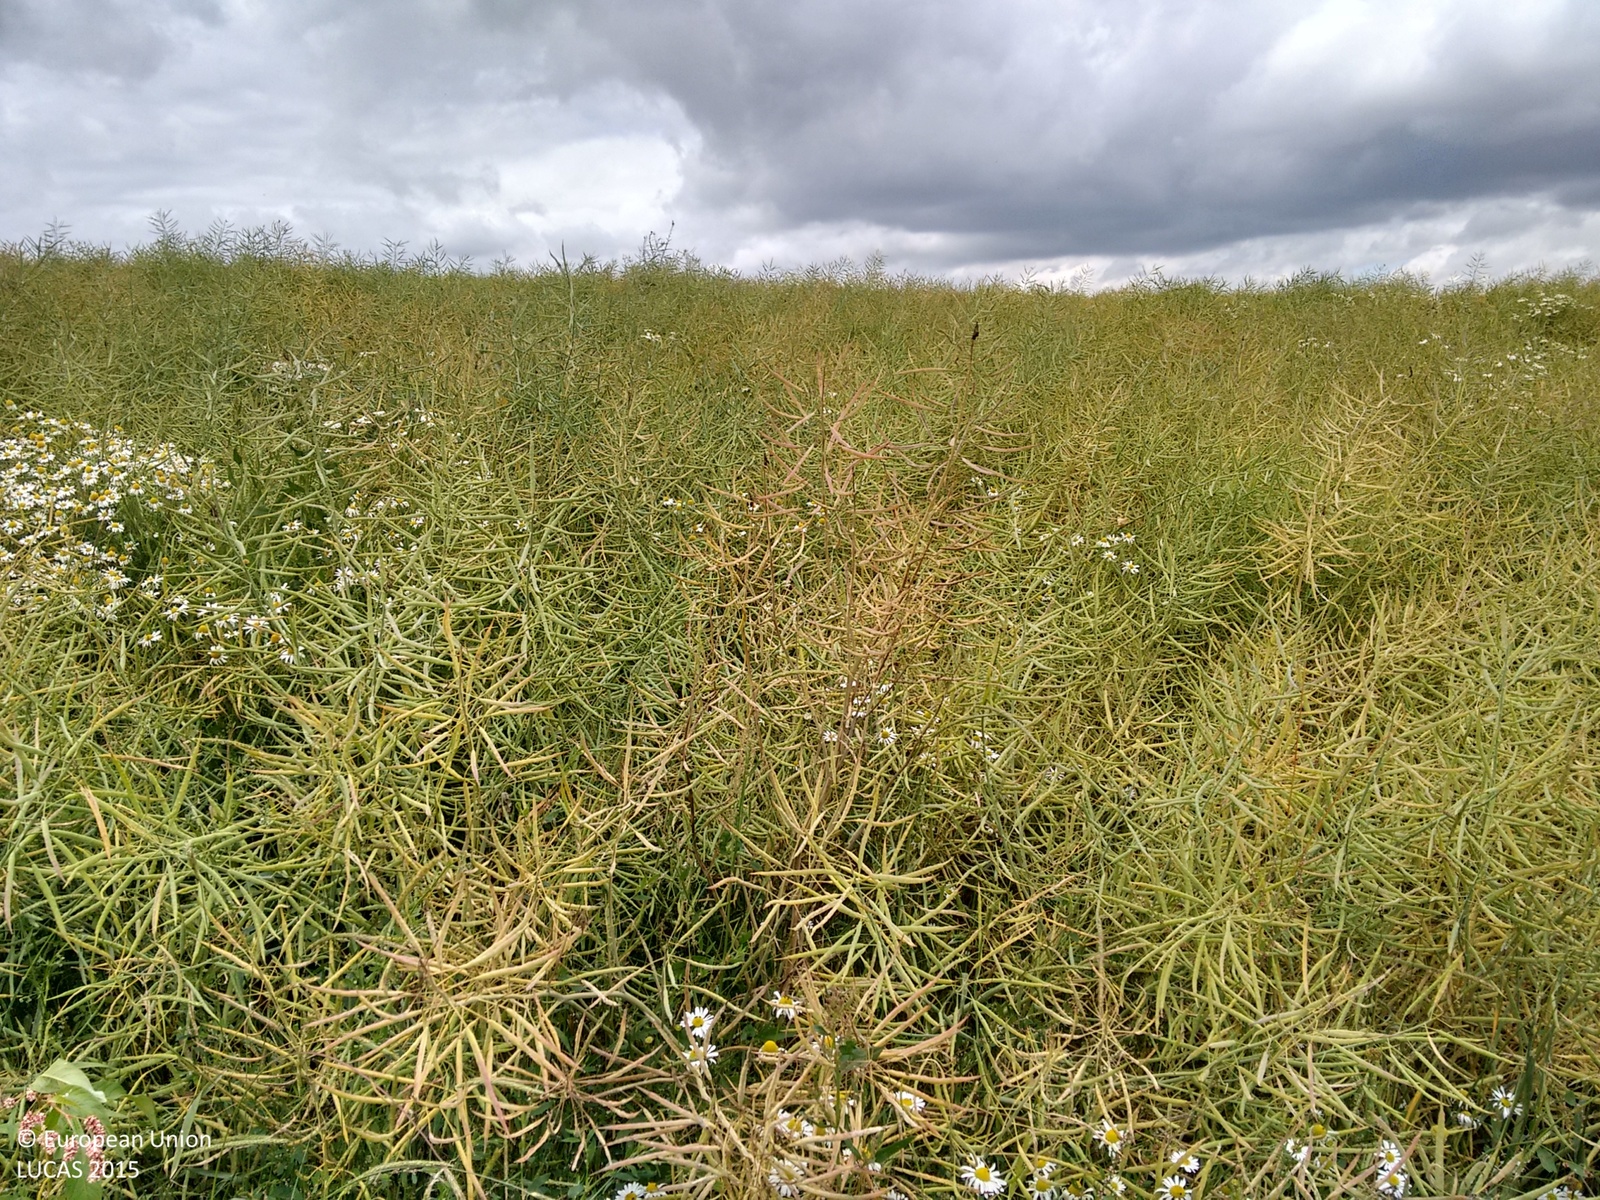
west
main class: Cropland
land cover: Rape and turnip rape
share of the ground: > 75 %
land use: Agriculture (excluding fallow land and kitchen gardens)
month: July
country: GB
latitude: 52.6863
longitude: -0.9462
